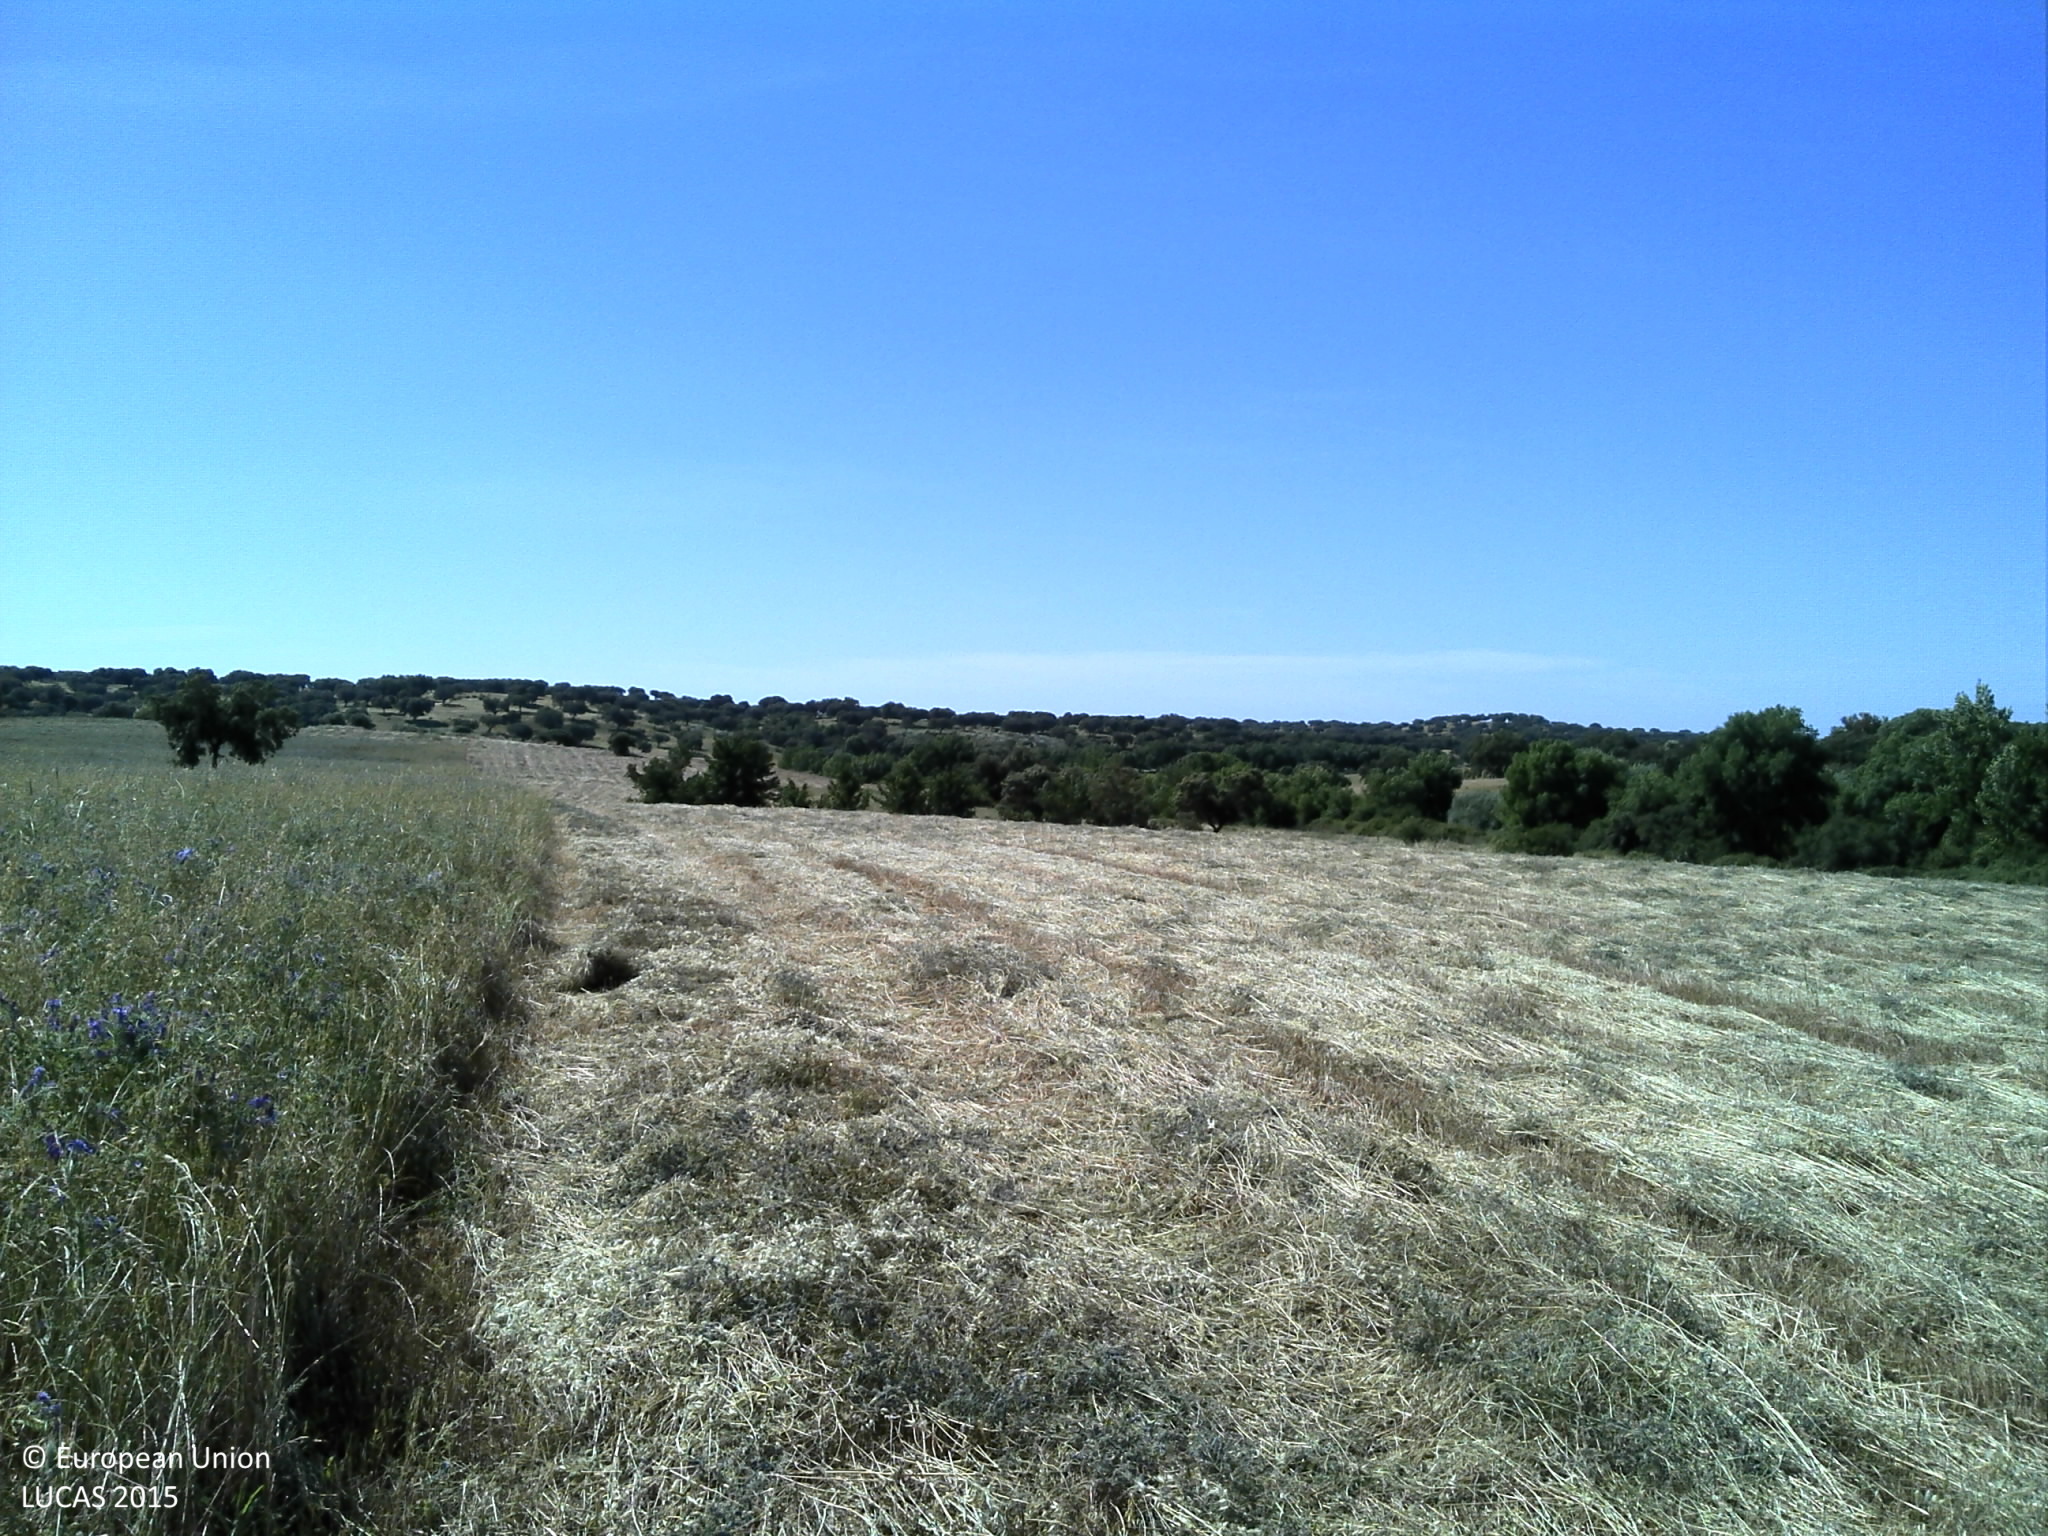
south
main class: Cropland
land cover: Temporary grasslands
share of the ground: > 75 %
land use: Agriculture (excluding fallow land and kitchen gardens)
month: May
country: PT
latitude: 39.1717
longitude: -7.8394
